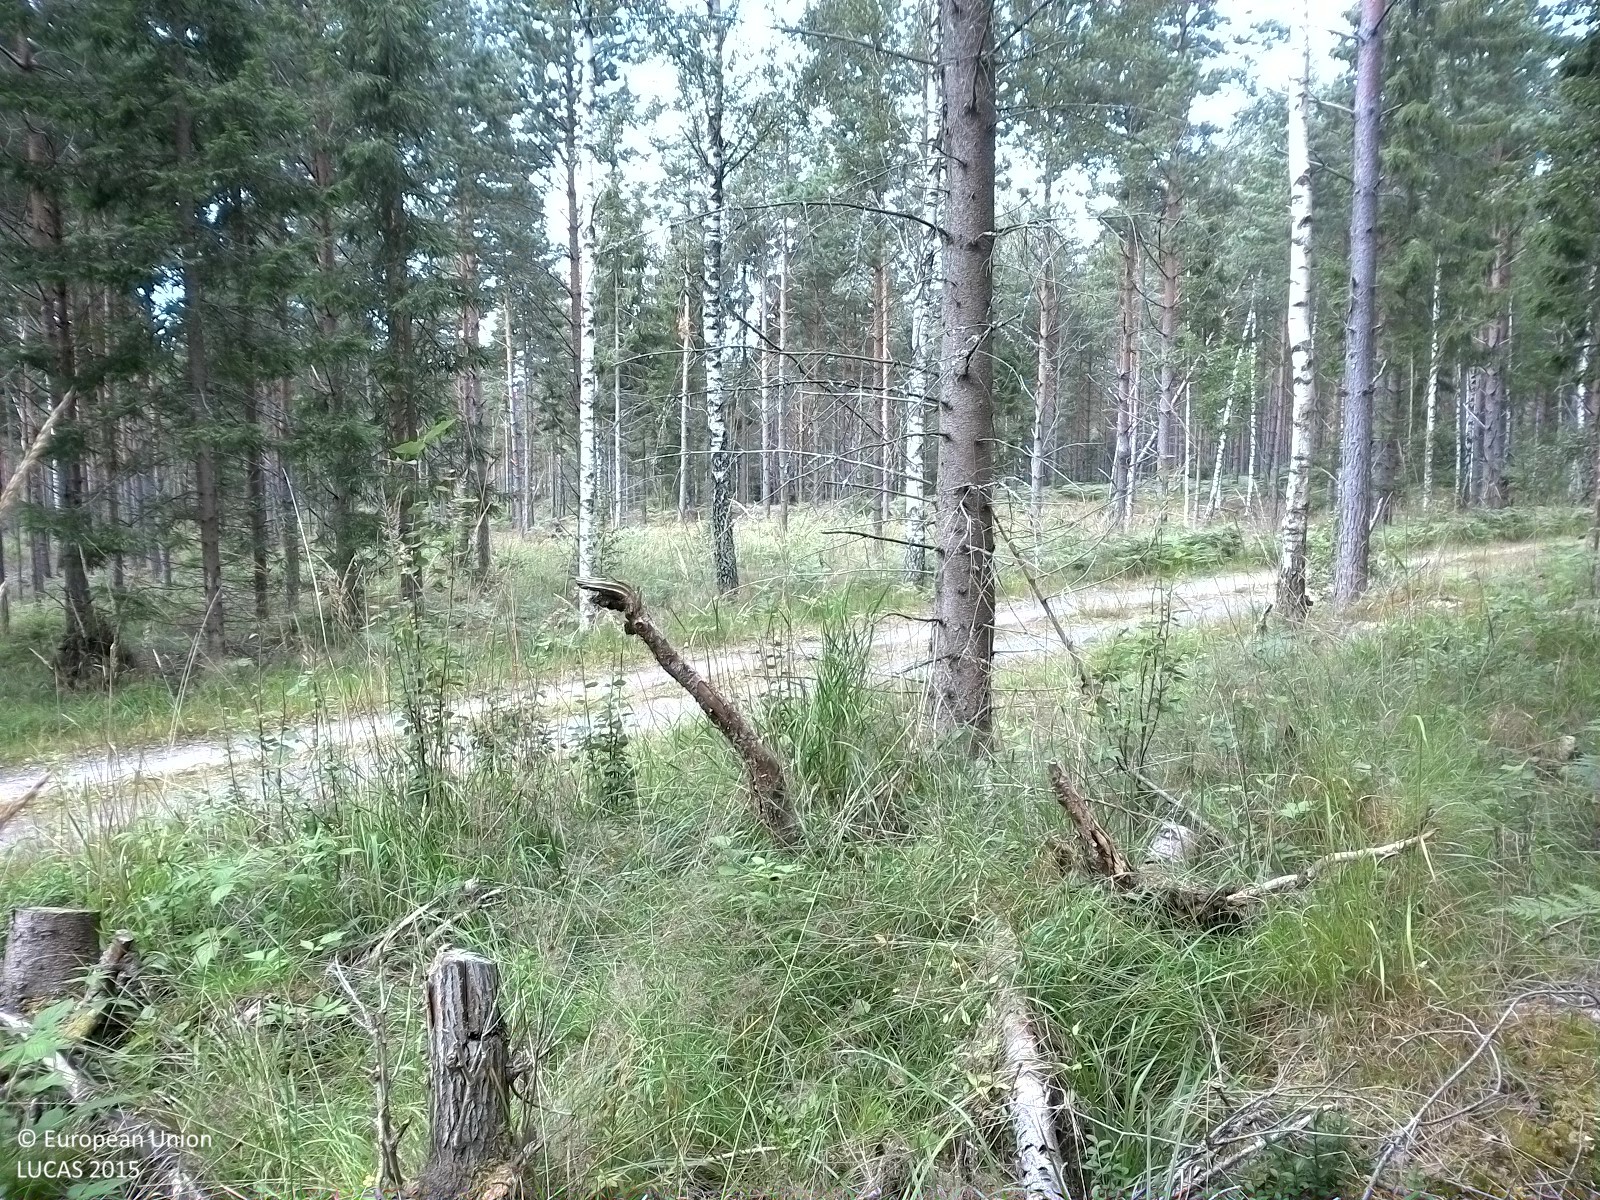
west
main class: Woodland
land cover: Pine dominated mixed woodland
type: boreal forest
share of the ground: 25 - 50 %
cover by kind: herbaceous plants 65 %, coniferous forest trees 20 %, broadleaved forest trees 10 %, lichens and mosses 5 %
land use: Forestry
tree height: > 5 m
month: August
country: SE
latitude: 59.0218
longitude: 15.1656
